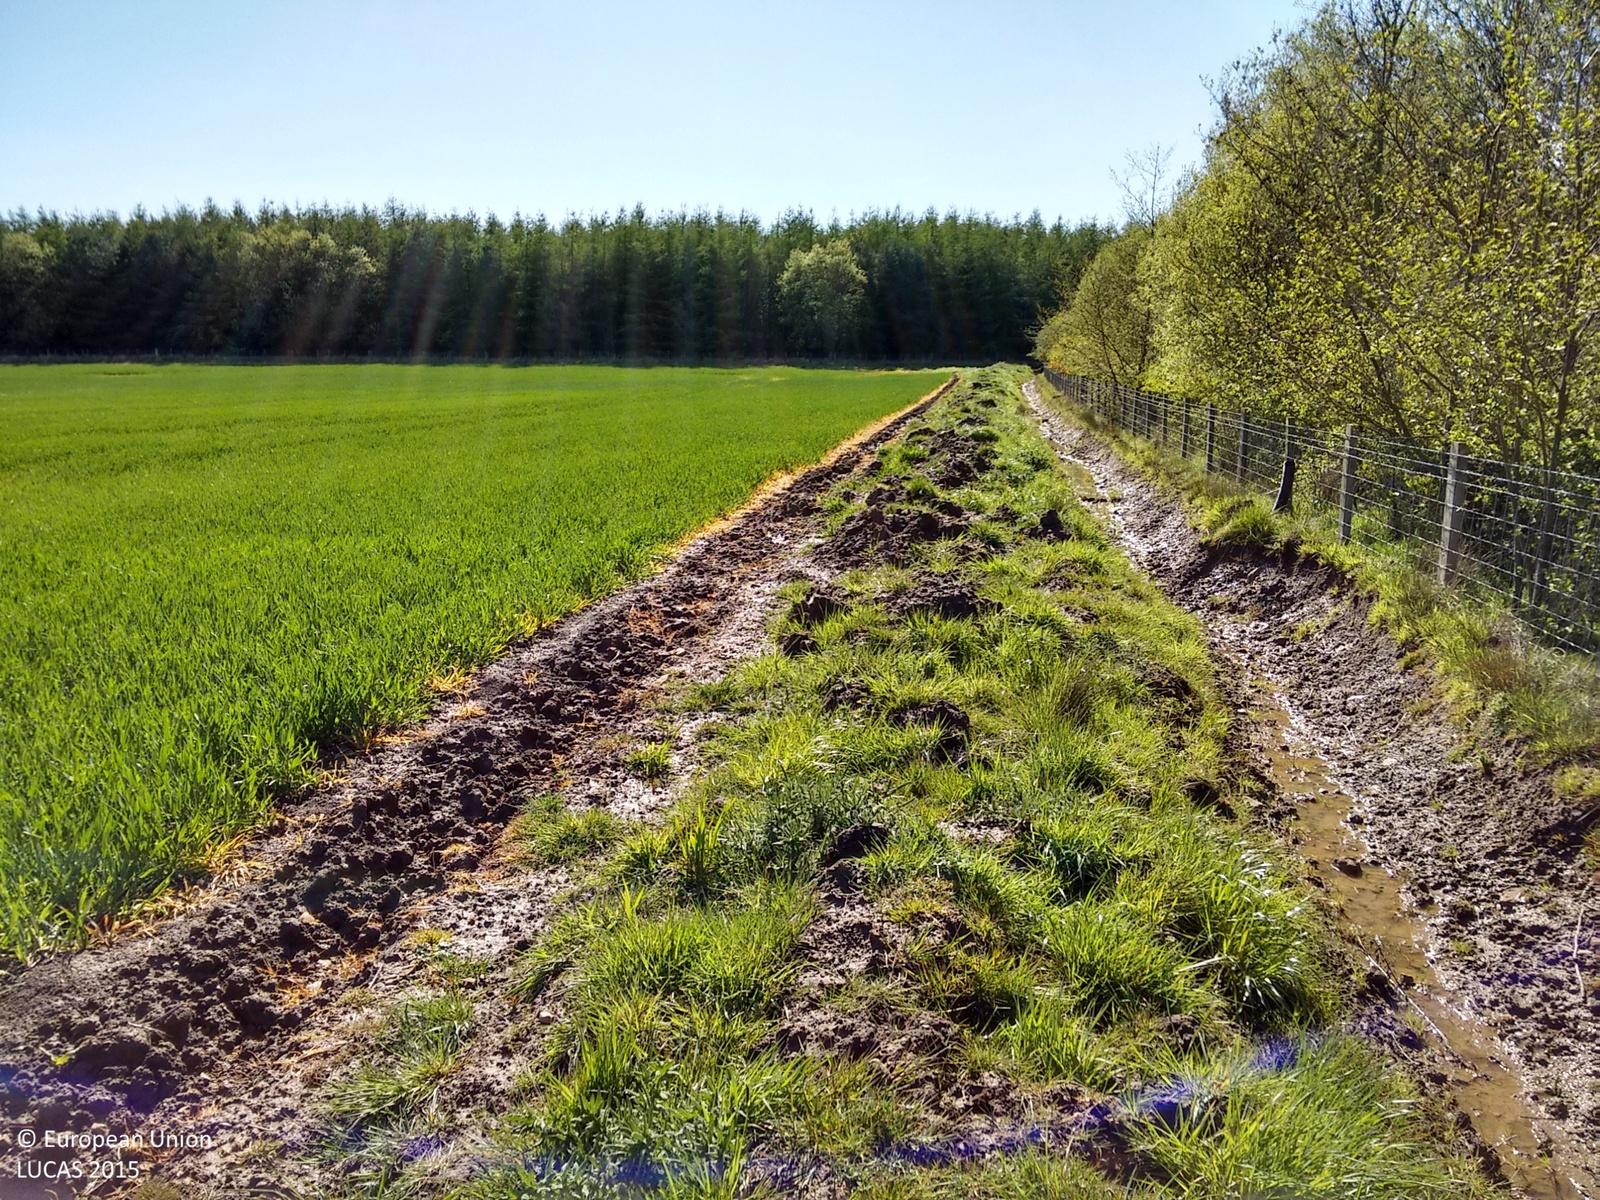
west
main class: Woodland
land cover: Pine dominated coniferous woodland
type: exotic forest
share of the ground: > 75 %
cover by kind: coniferous forest trees 100 %
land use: Forestry
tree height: > 5 m
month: May
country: GB
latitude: 55.1966
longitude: -1.6905
